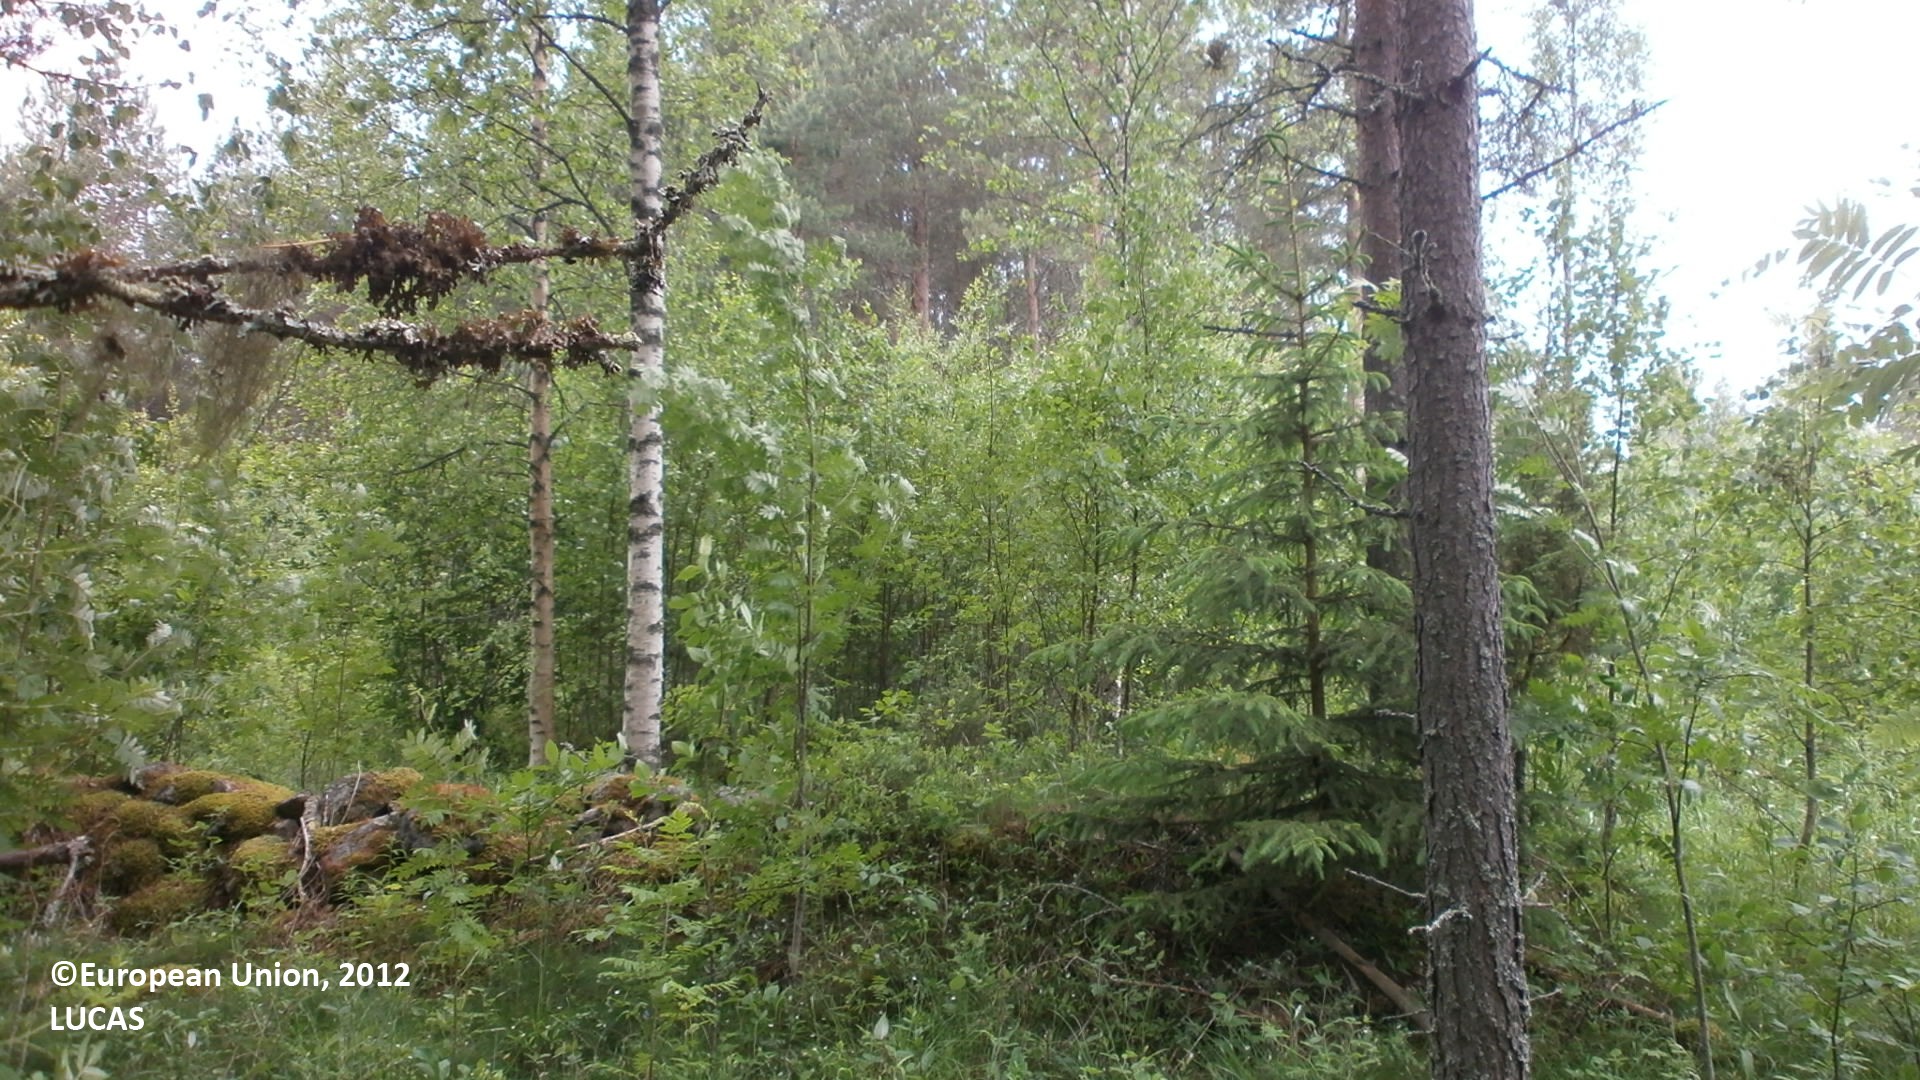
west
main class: Woodland
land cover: Other coniferous woodland
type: boreal forest
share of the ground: 50 - 75 %
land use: Forestry
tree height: > 5 m
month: June
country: FI
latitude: 64.6144
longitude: 25.0687
